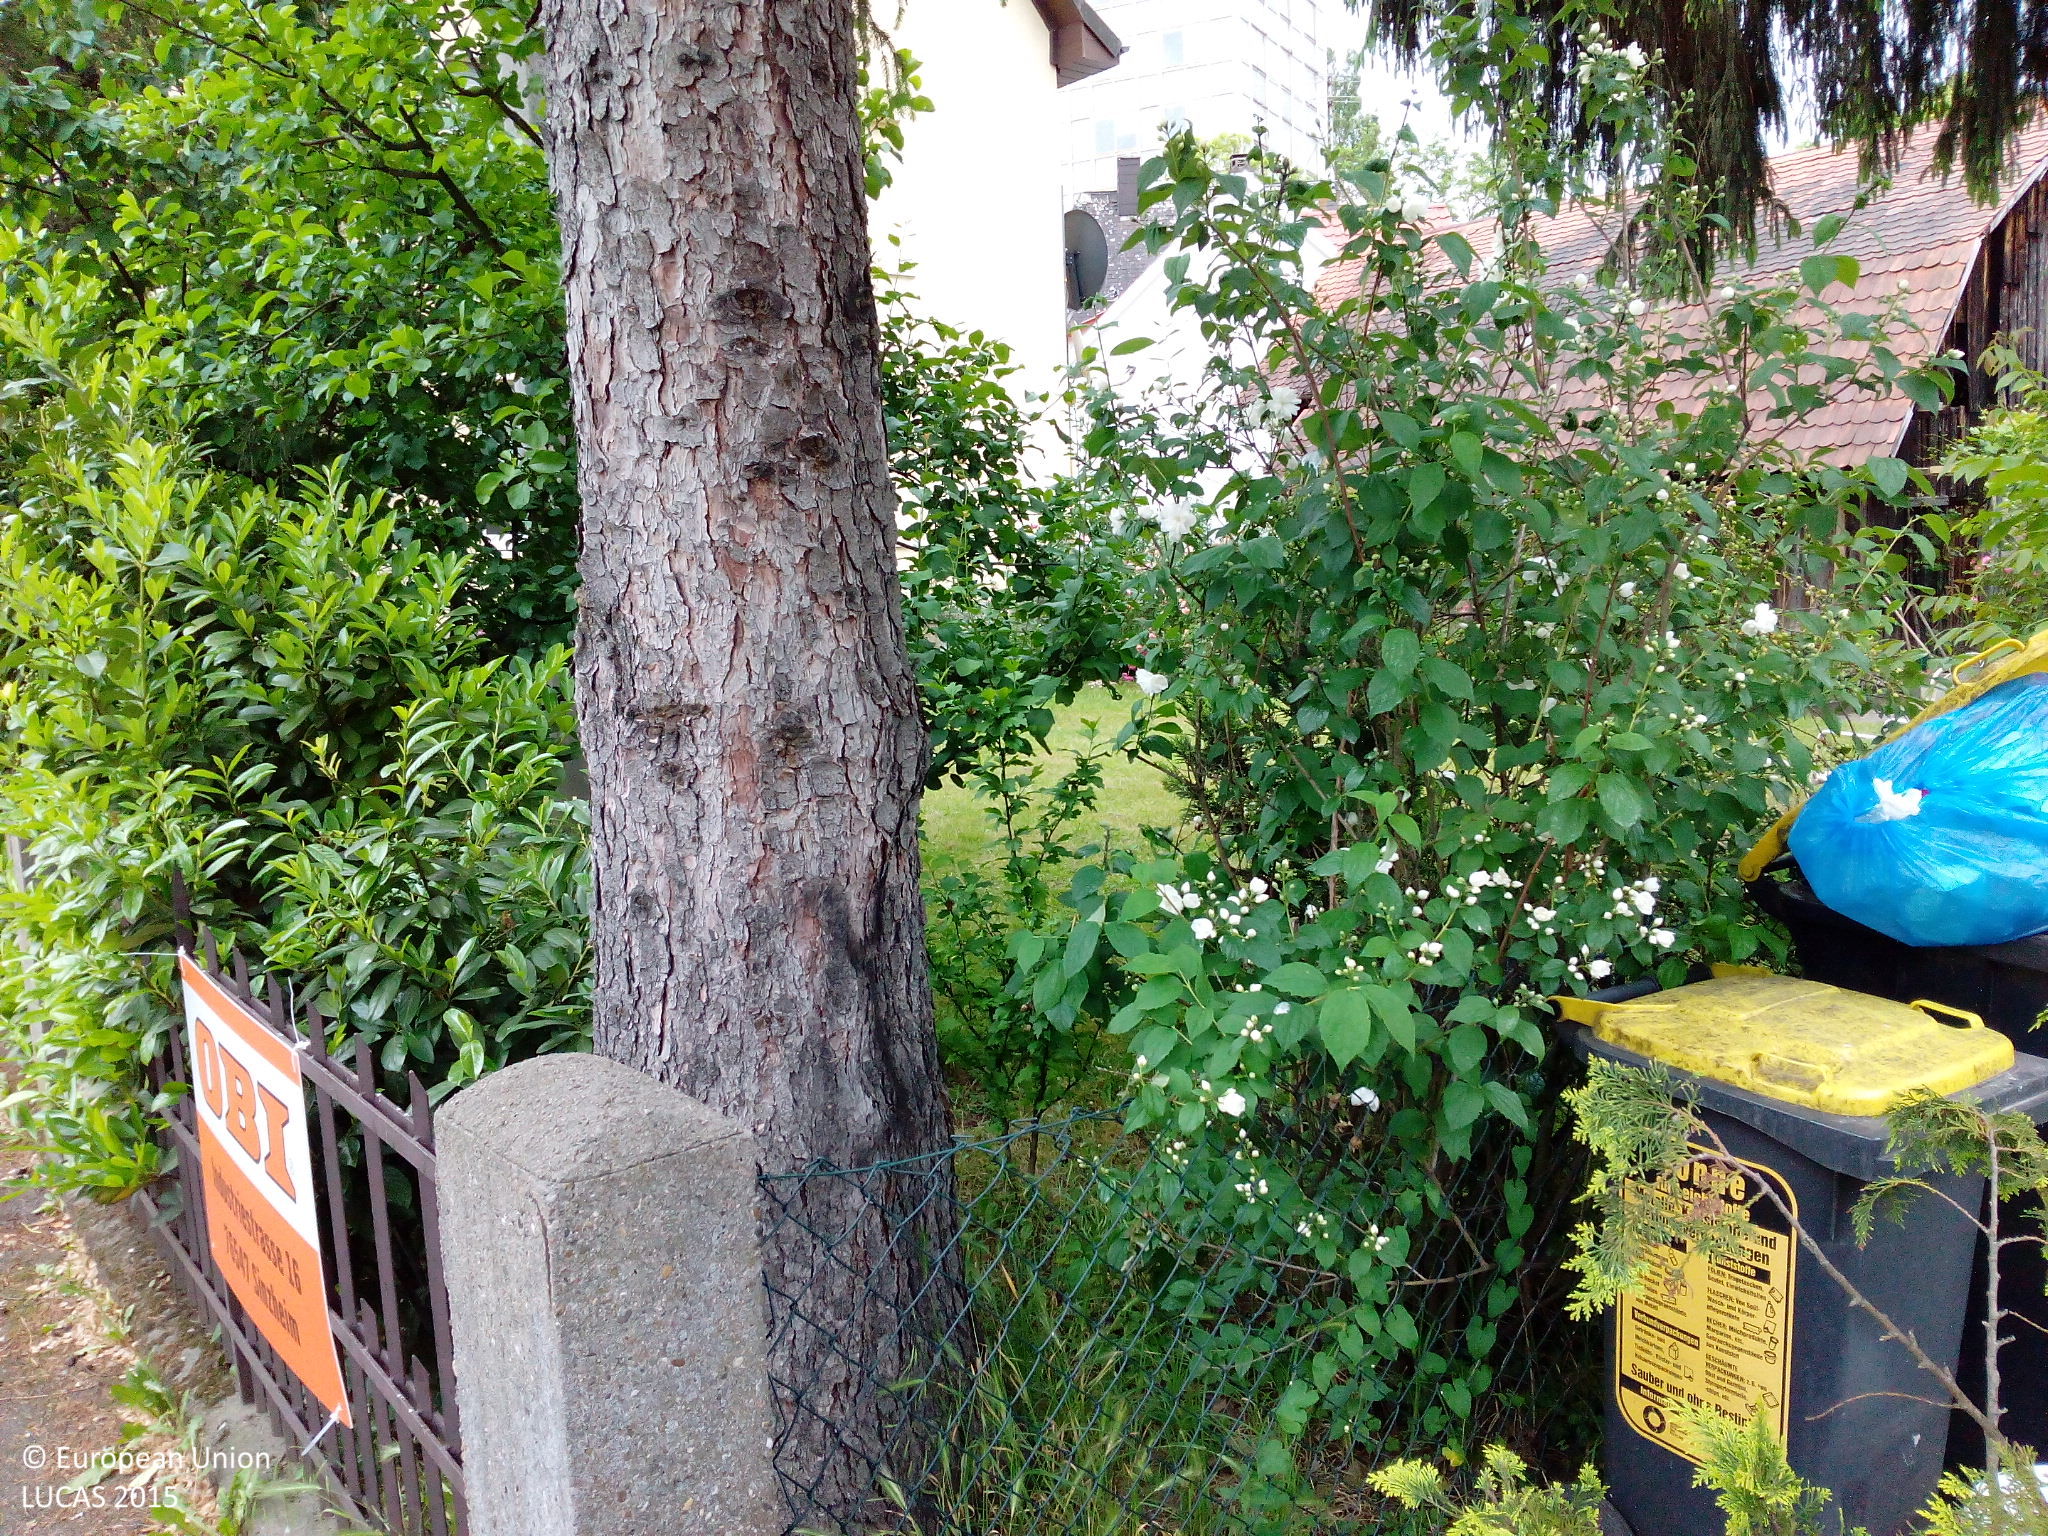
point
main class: Grassland
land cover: Grassland without tree/shrub cover
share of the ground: > 75 %
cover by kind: herbaceous plants 90 %, unconsolidated bare surface 10 %
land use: Residential
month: May
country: DE
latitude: 48.7846
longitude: 8.1905
